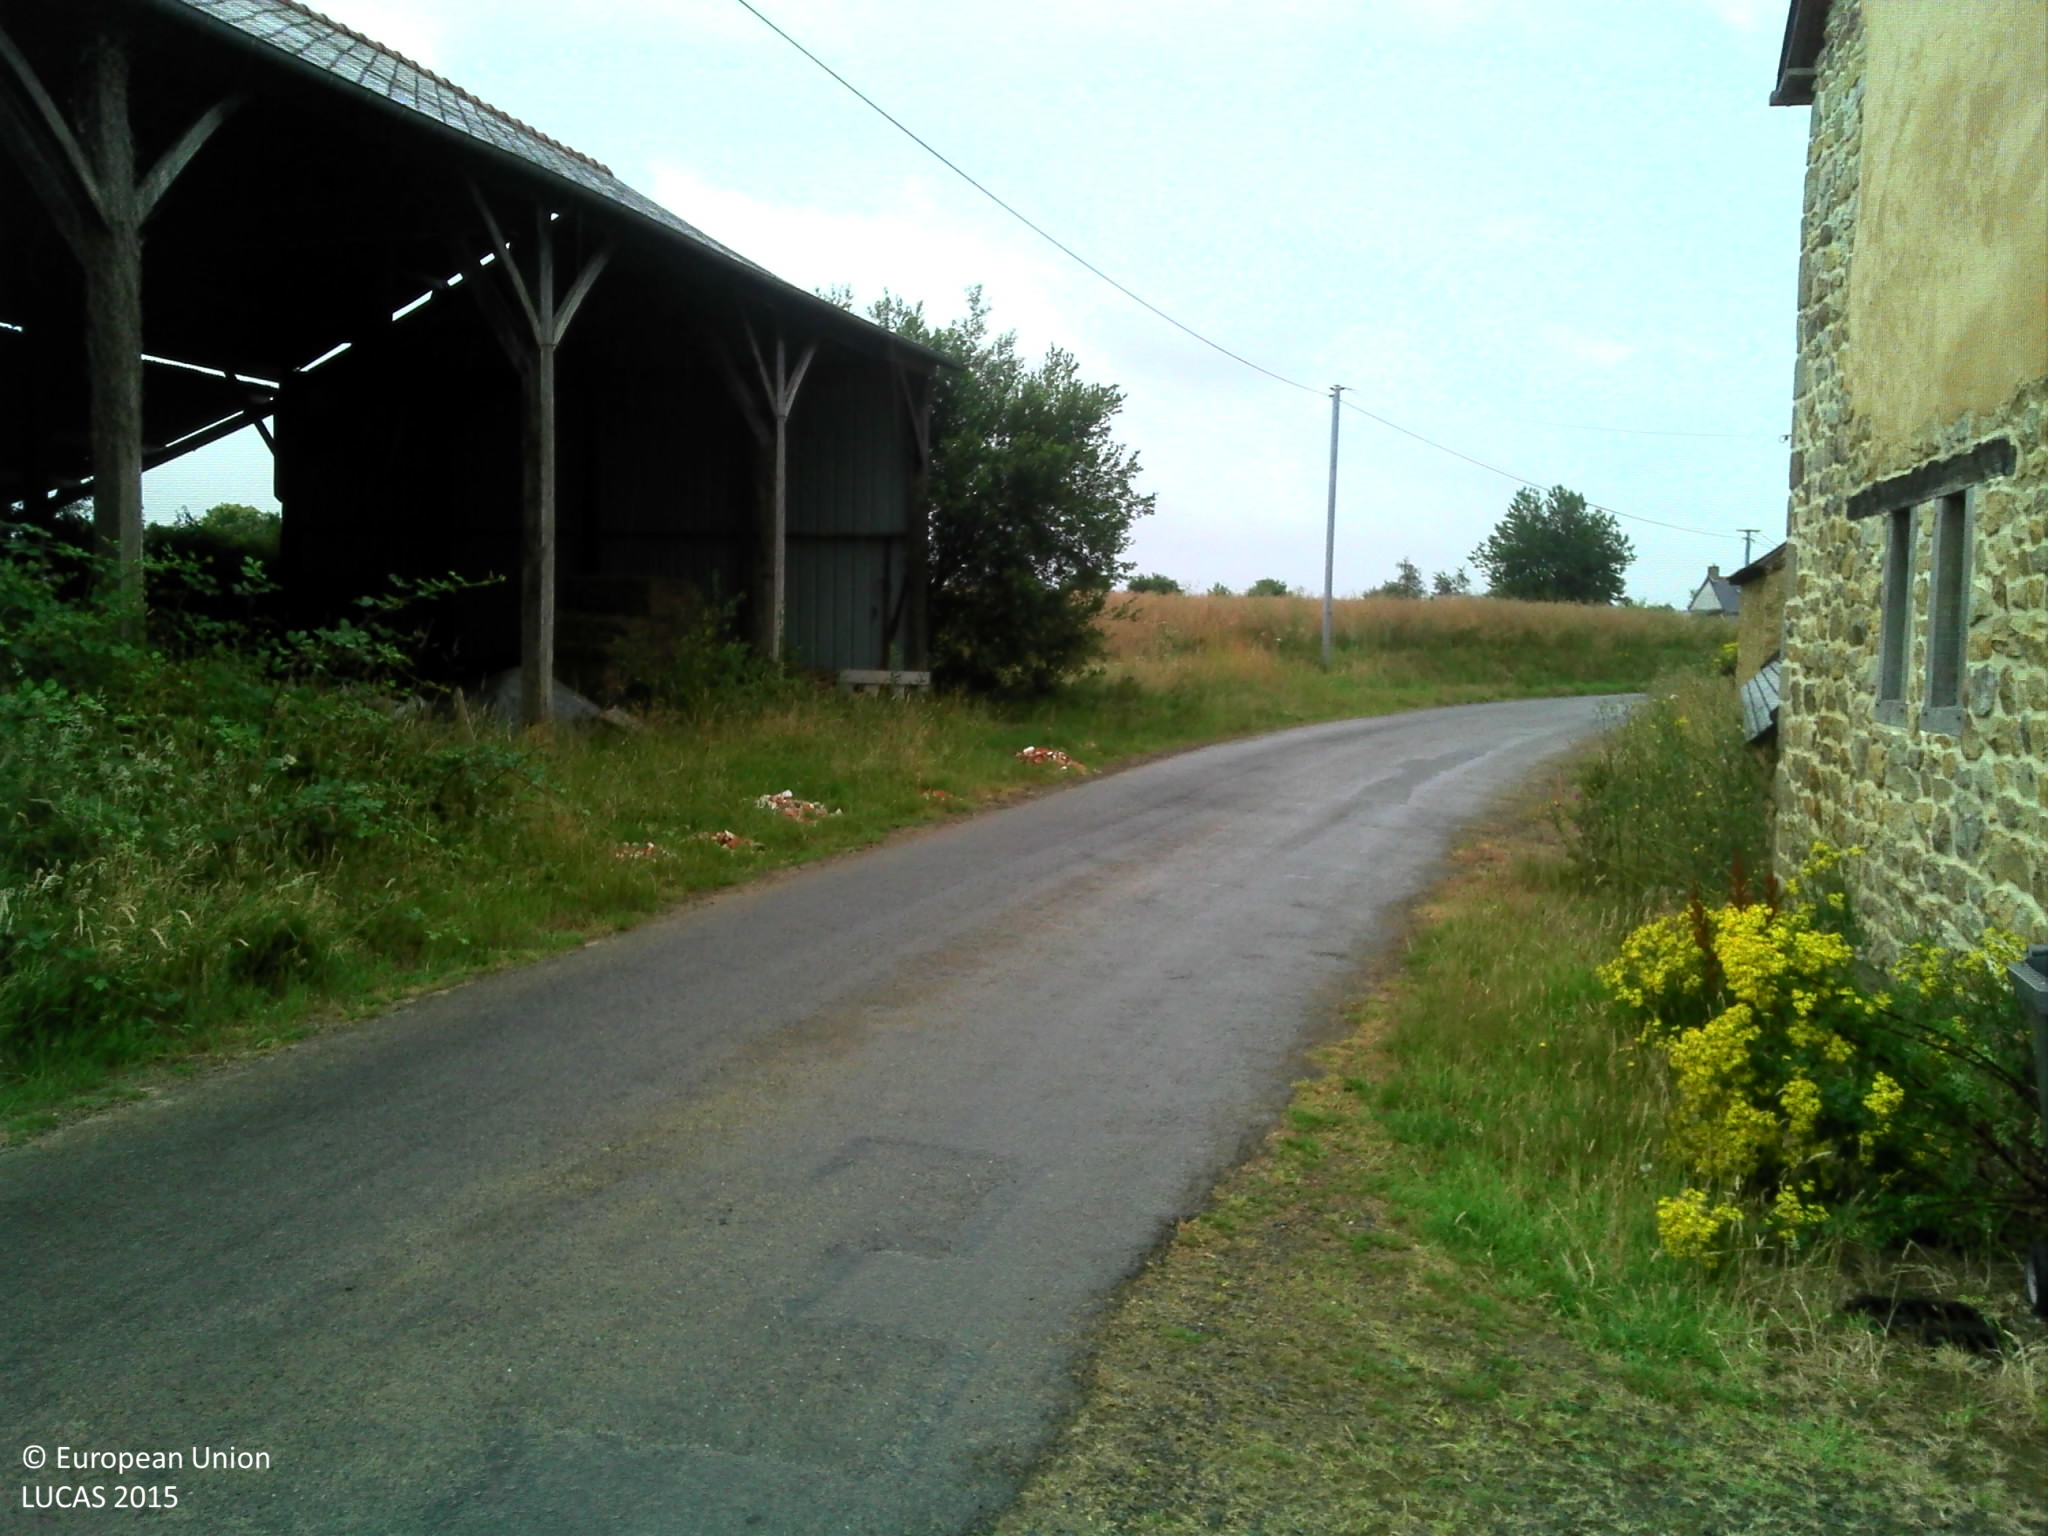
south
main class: Grassland
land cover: Grassland without tree/shrub cover
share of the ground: > 75 %
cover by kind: herbaceous plants 100 %
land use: Agriculture (excluding fallow land and kitchen gardens)
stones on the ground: 10 - 25 %
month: July
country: FR
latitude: 48.2623
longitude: -1.9472
